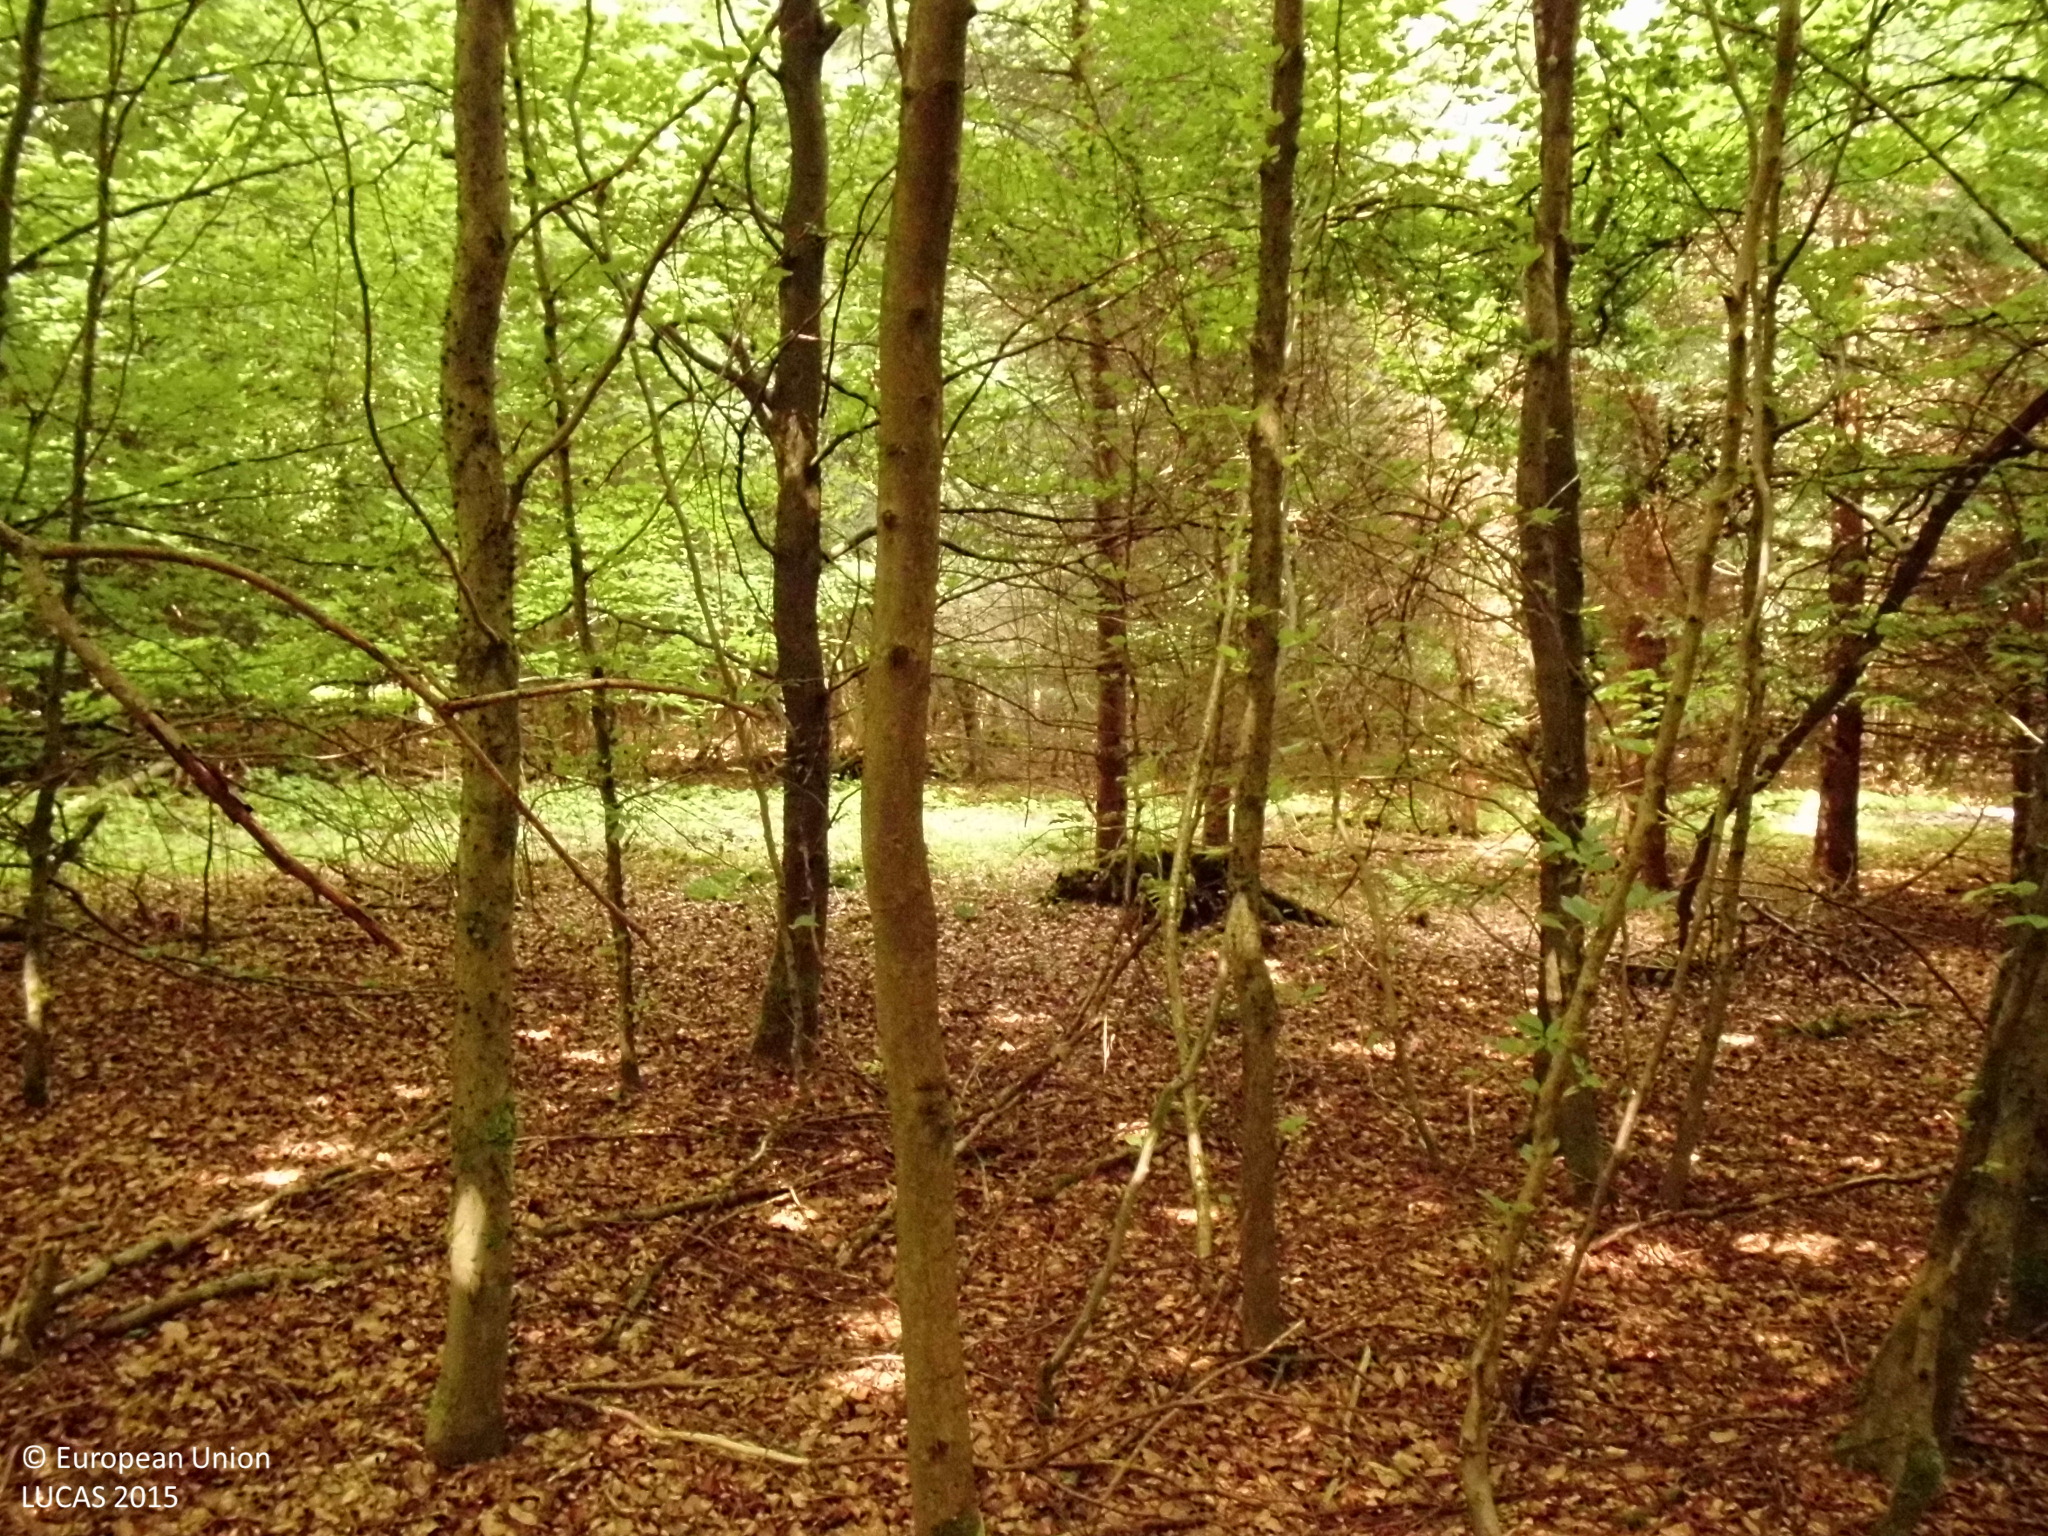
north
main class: Woodland
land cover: Spruce dominated mixed woodland
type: hemiboreal forest and nemoral coniferous forest and mixed broadleaved-coniferous forest
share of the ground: > 75 %
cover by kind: coniferous forest trees 70 %, broadleaved forest trees 30 %
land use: Forestry
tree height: > 5 m
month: May
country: DE
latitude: 50.5539
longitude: 7.5585
